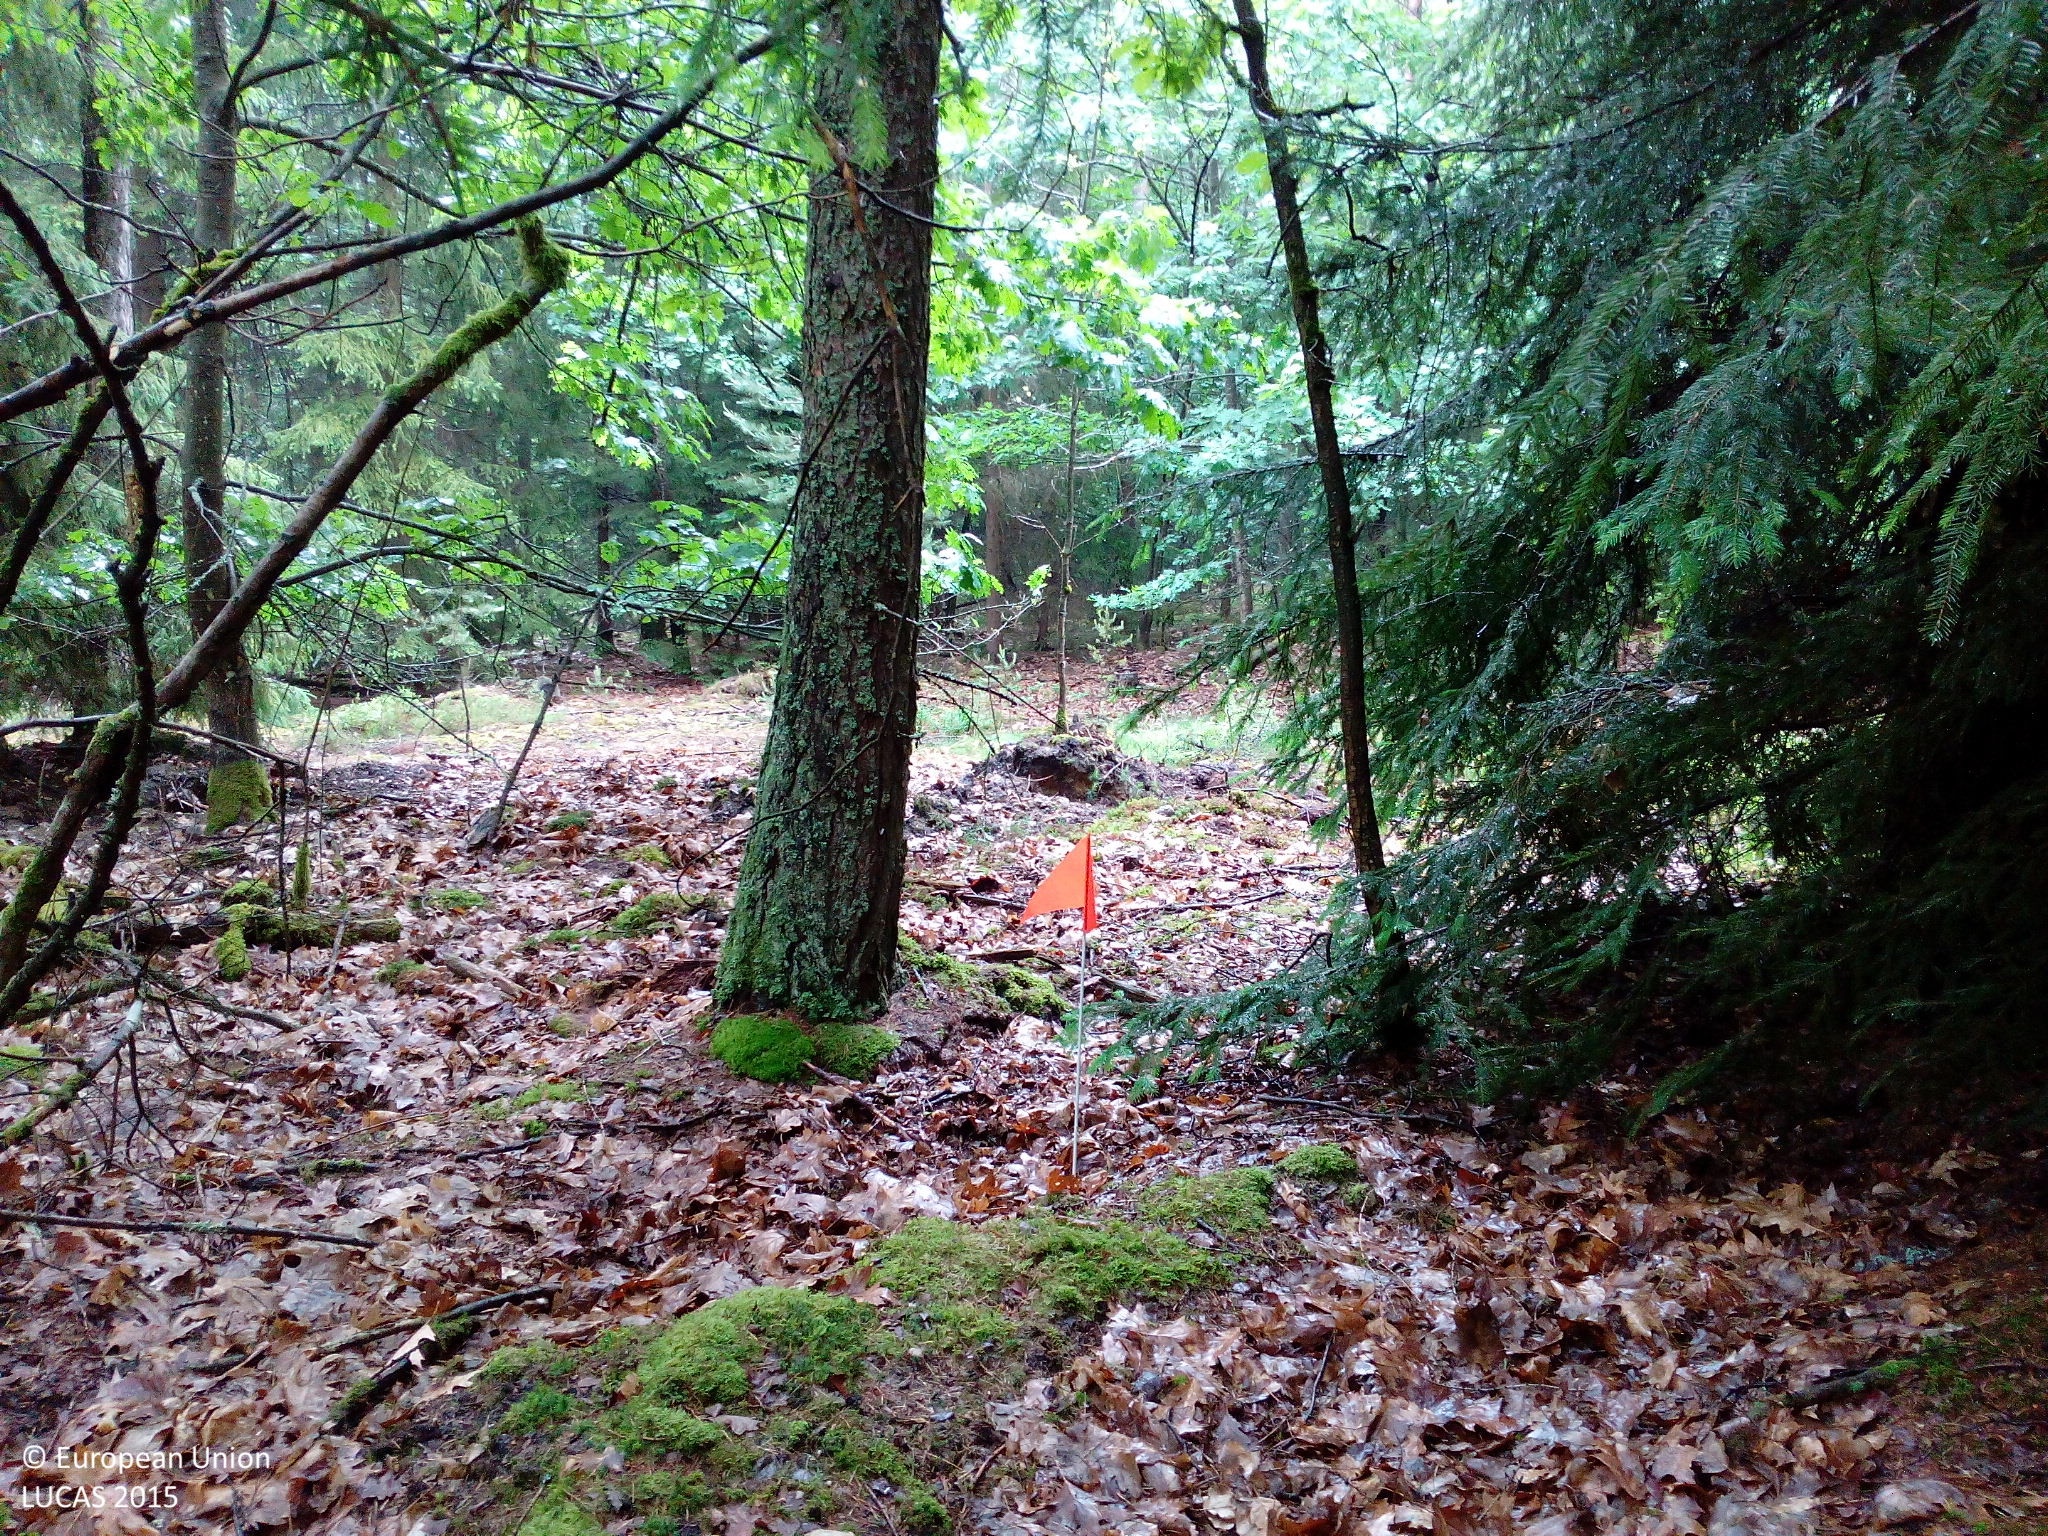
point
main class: Woodland
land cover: Other mixed woodland
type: hemiboreal forest and nemoral coniferous forest and mixed broadleaved-coniferous forest
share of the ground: > 75 %
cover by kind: coniferous forest trees 75 %, broadleaved forest trees 25 %
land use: Forestry
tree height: > 5 m
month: June
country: DE
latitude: 49.2632
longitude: 12.2119
